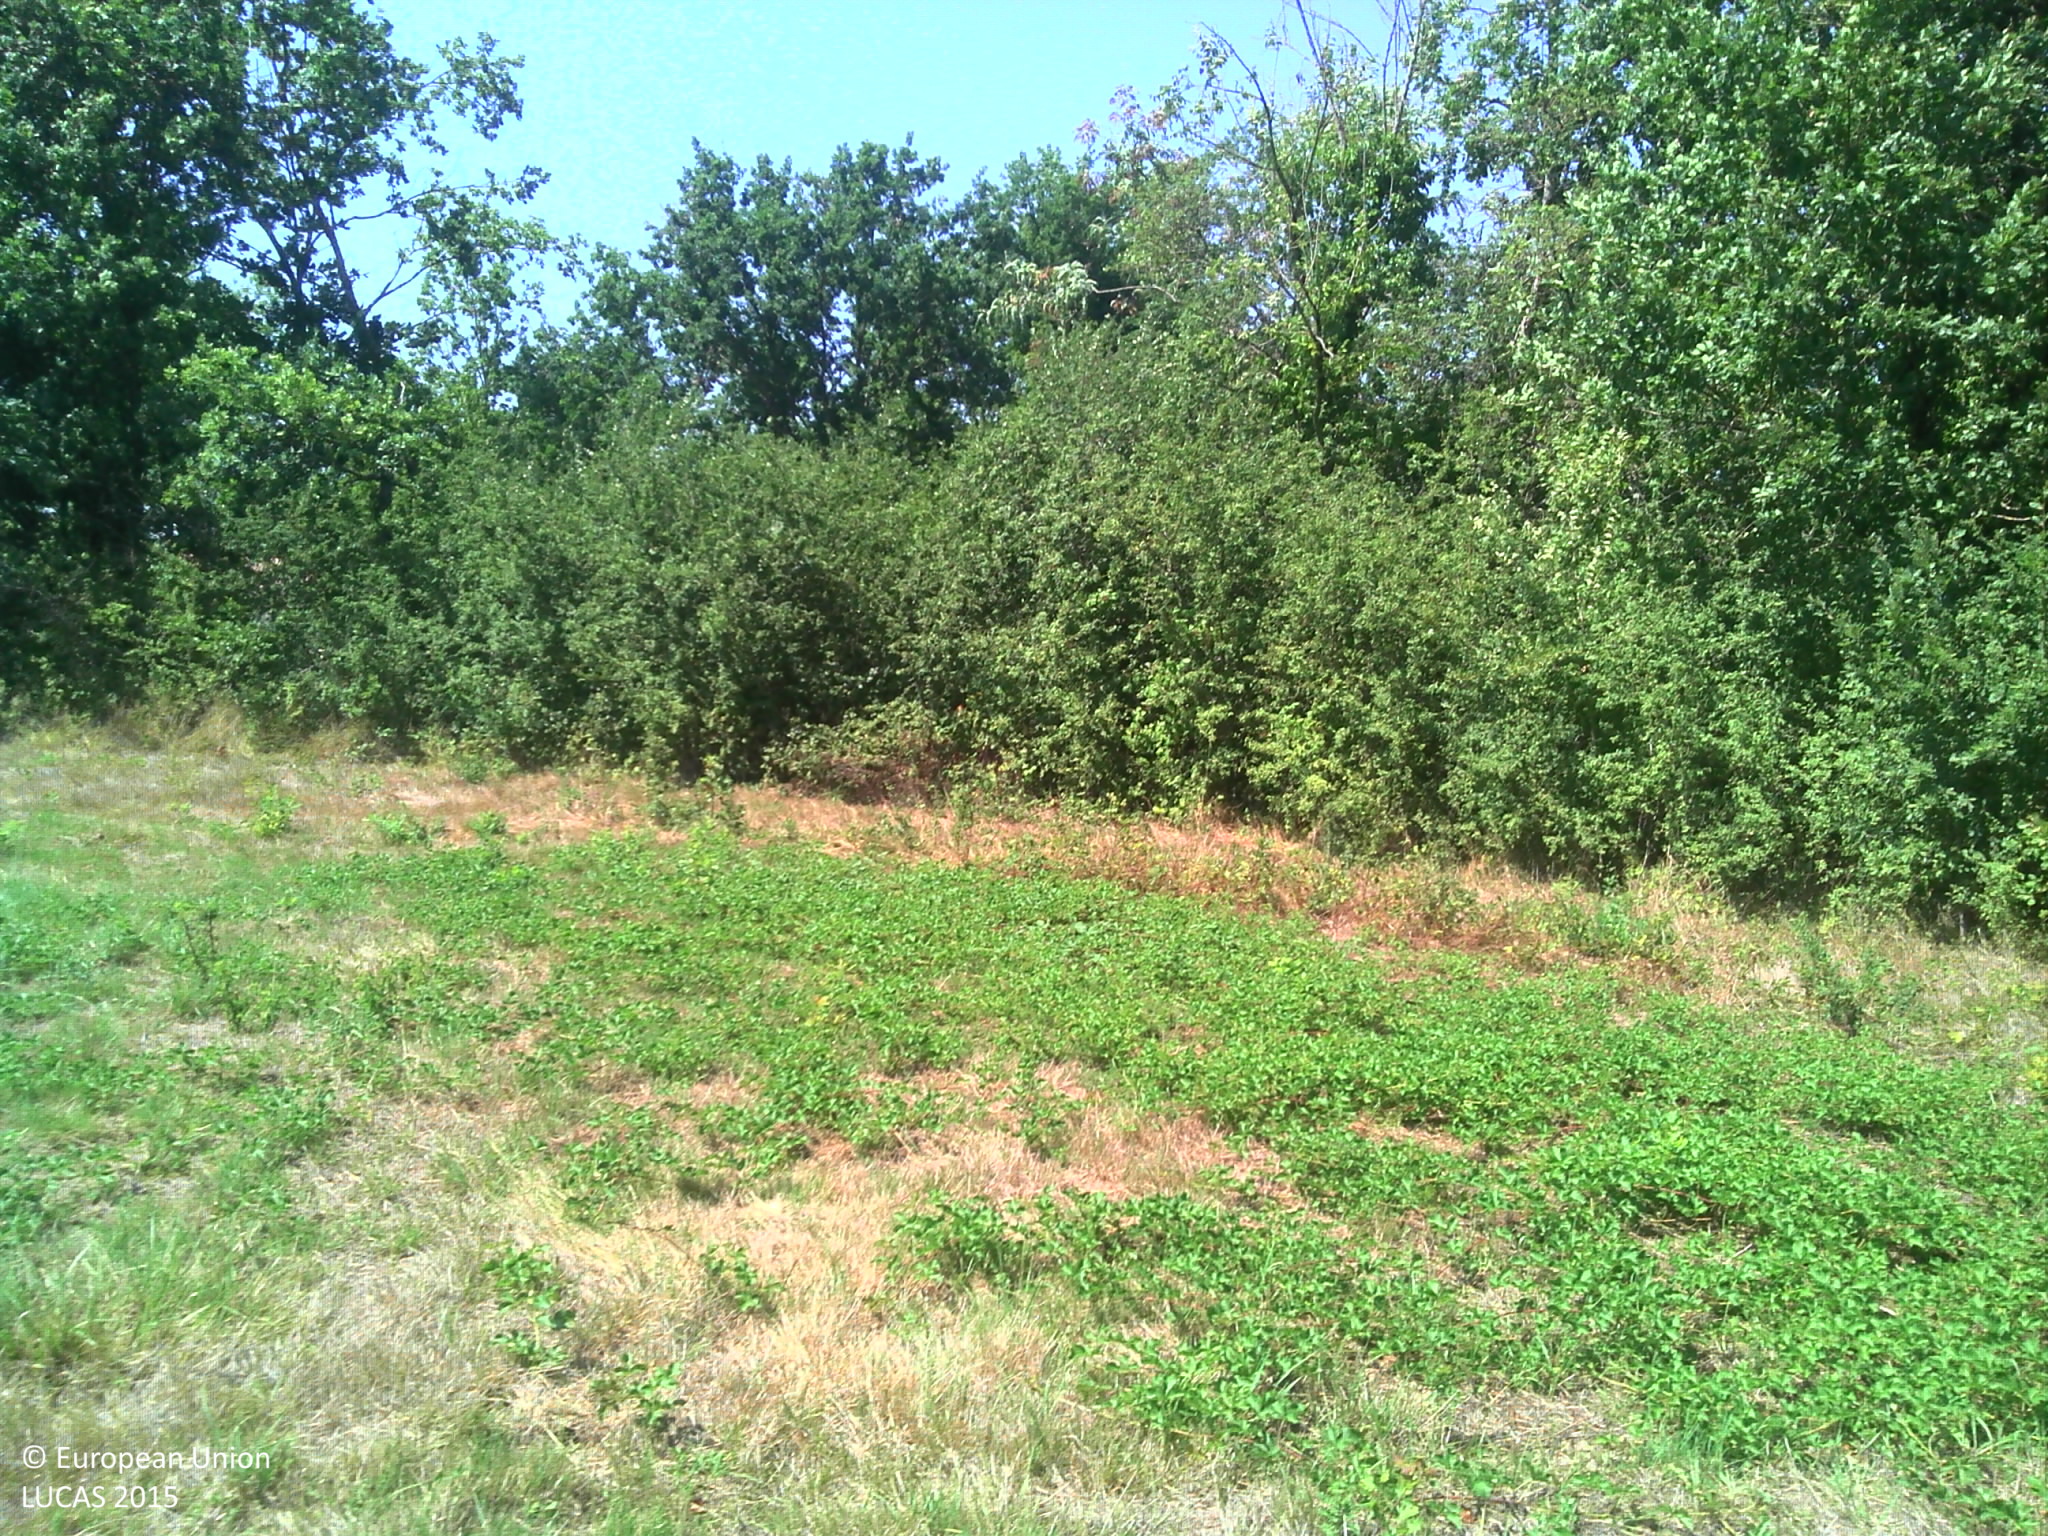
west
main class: Grassland
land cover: Grassland without tree/shrub cover
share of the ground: > 75 %
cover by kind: herbaceous plants 95 %, shrubs 5 %
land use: Agriculture (excluding fallow land and kitchen gardens)
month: August
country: FR
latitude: 44.0591
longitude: 1.3237
